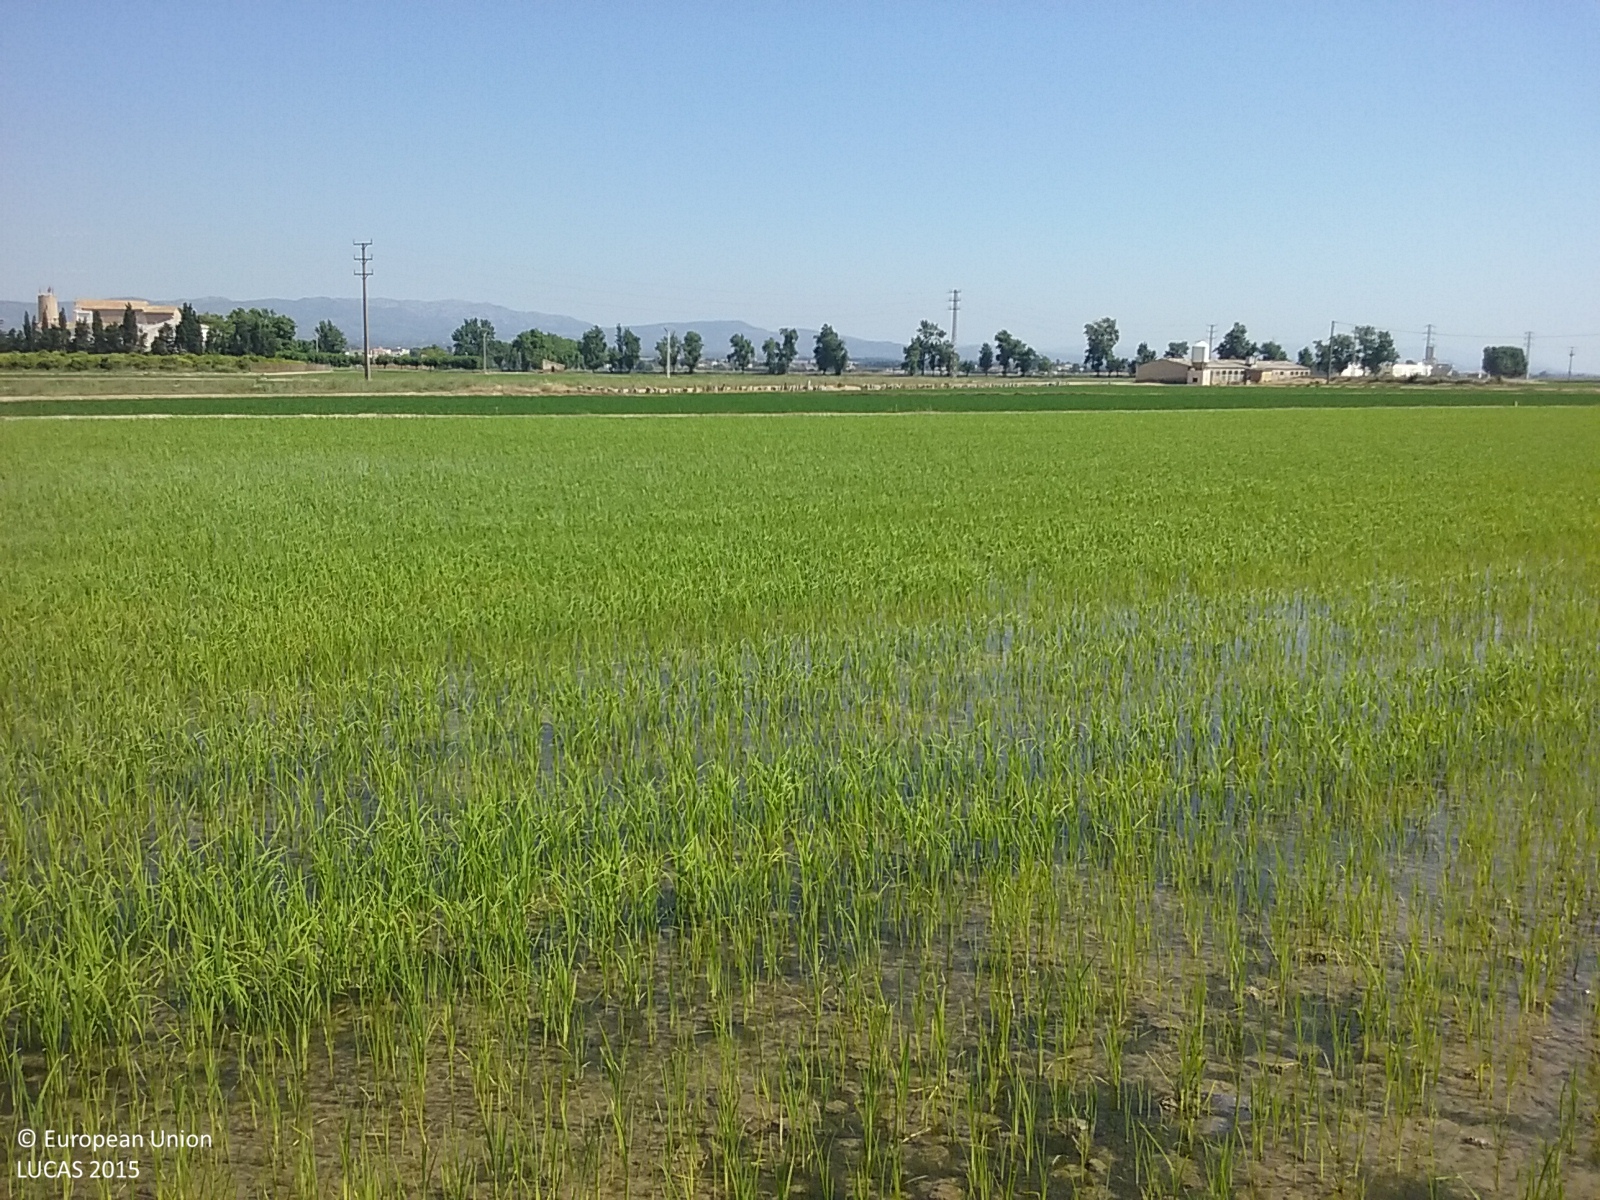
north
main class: Cropland
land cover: Rice
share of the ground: 50 - 75 %
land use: Agriculture (excluding fallow land and kitchen gardens)
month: June
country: ES
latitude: 40.7279
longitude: 0.6296
